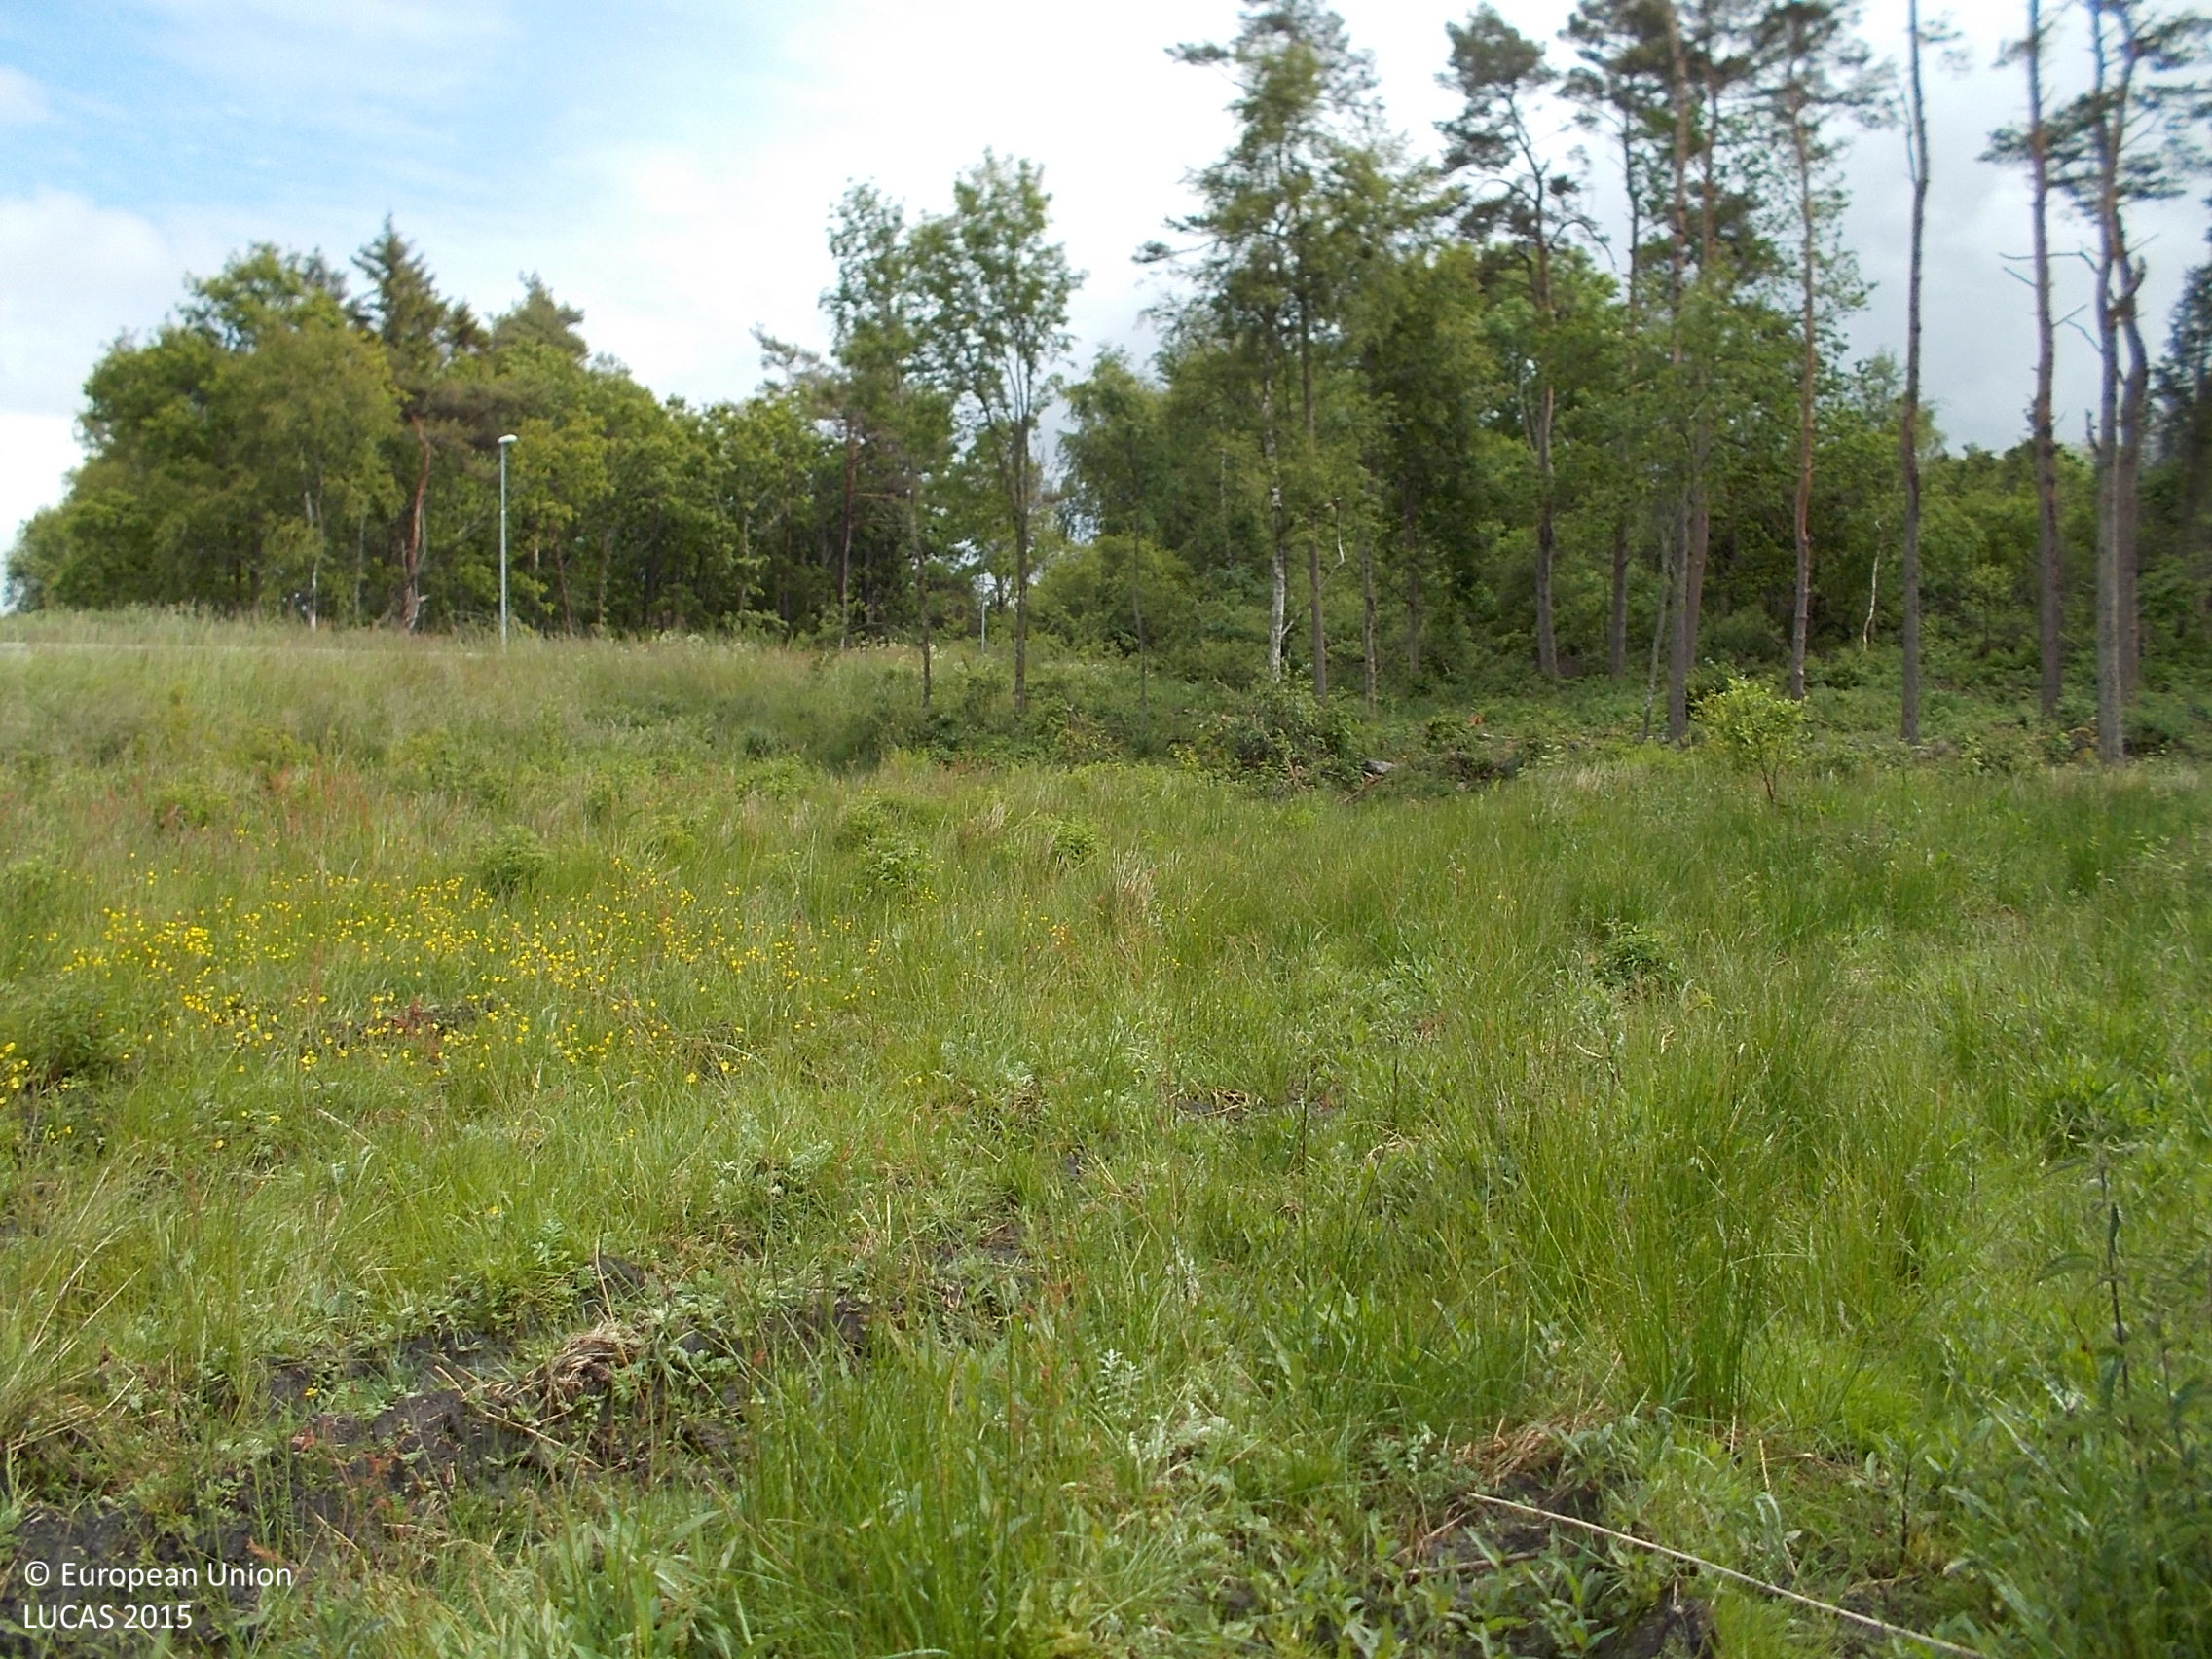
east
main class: Grassland
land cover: Spontaneously vegetated surfaces
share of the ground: > 75 %
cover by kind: herbaceous plants 95 %, shrubs 5 %
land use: Fallow land
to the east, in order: Spontaneously vegetated surfaces; Ditches and canals; Broadleaved woodland; Grass margins; Paved roads, cycling and walking lanes; Grass margins; Broadleaved woodland; Artificial constructions in urban areas; Abandoned hedges; Ditches and canals; Grassland without tree/shrub cover; Ditches and canals; Dry stone walls; Abandoned hedges; Shruby margins; Ditches and canals; Shruby margins; Other leguminous and mixtures for fodder
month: June
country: SE
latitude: 57.4499
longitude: 11.9467
